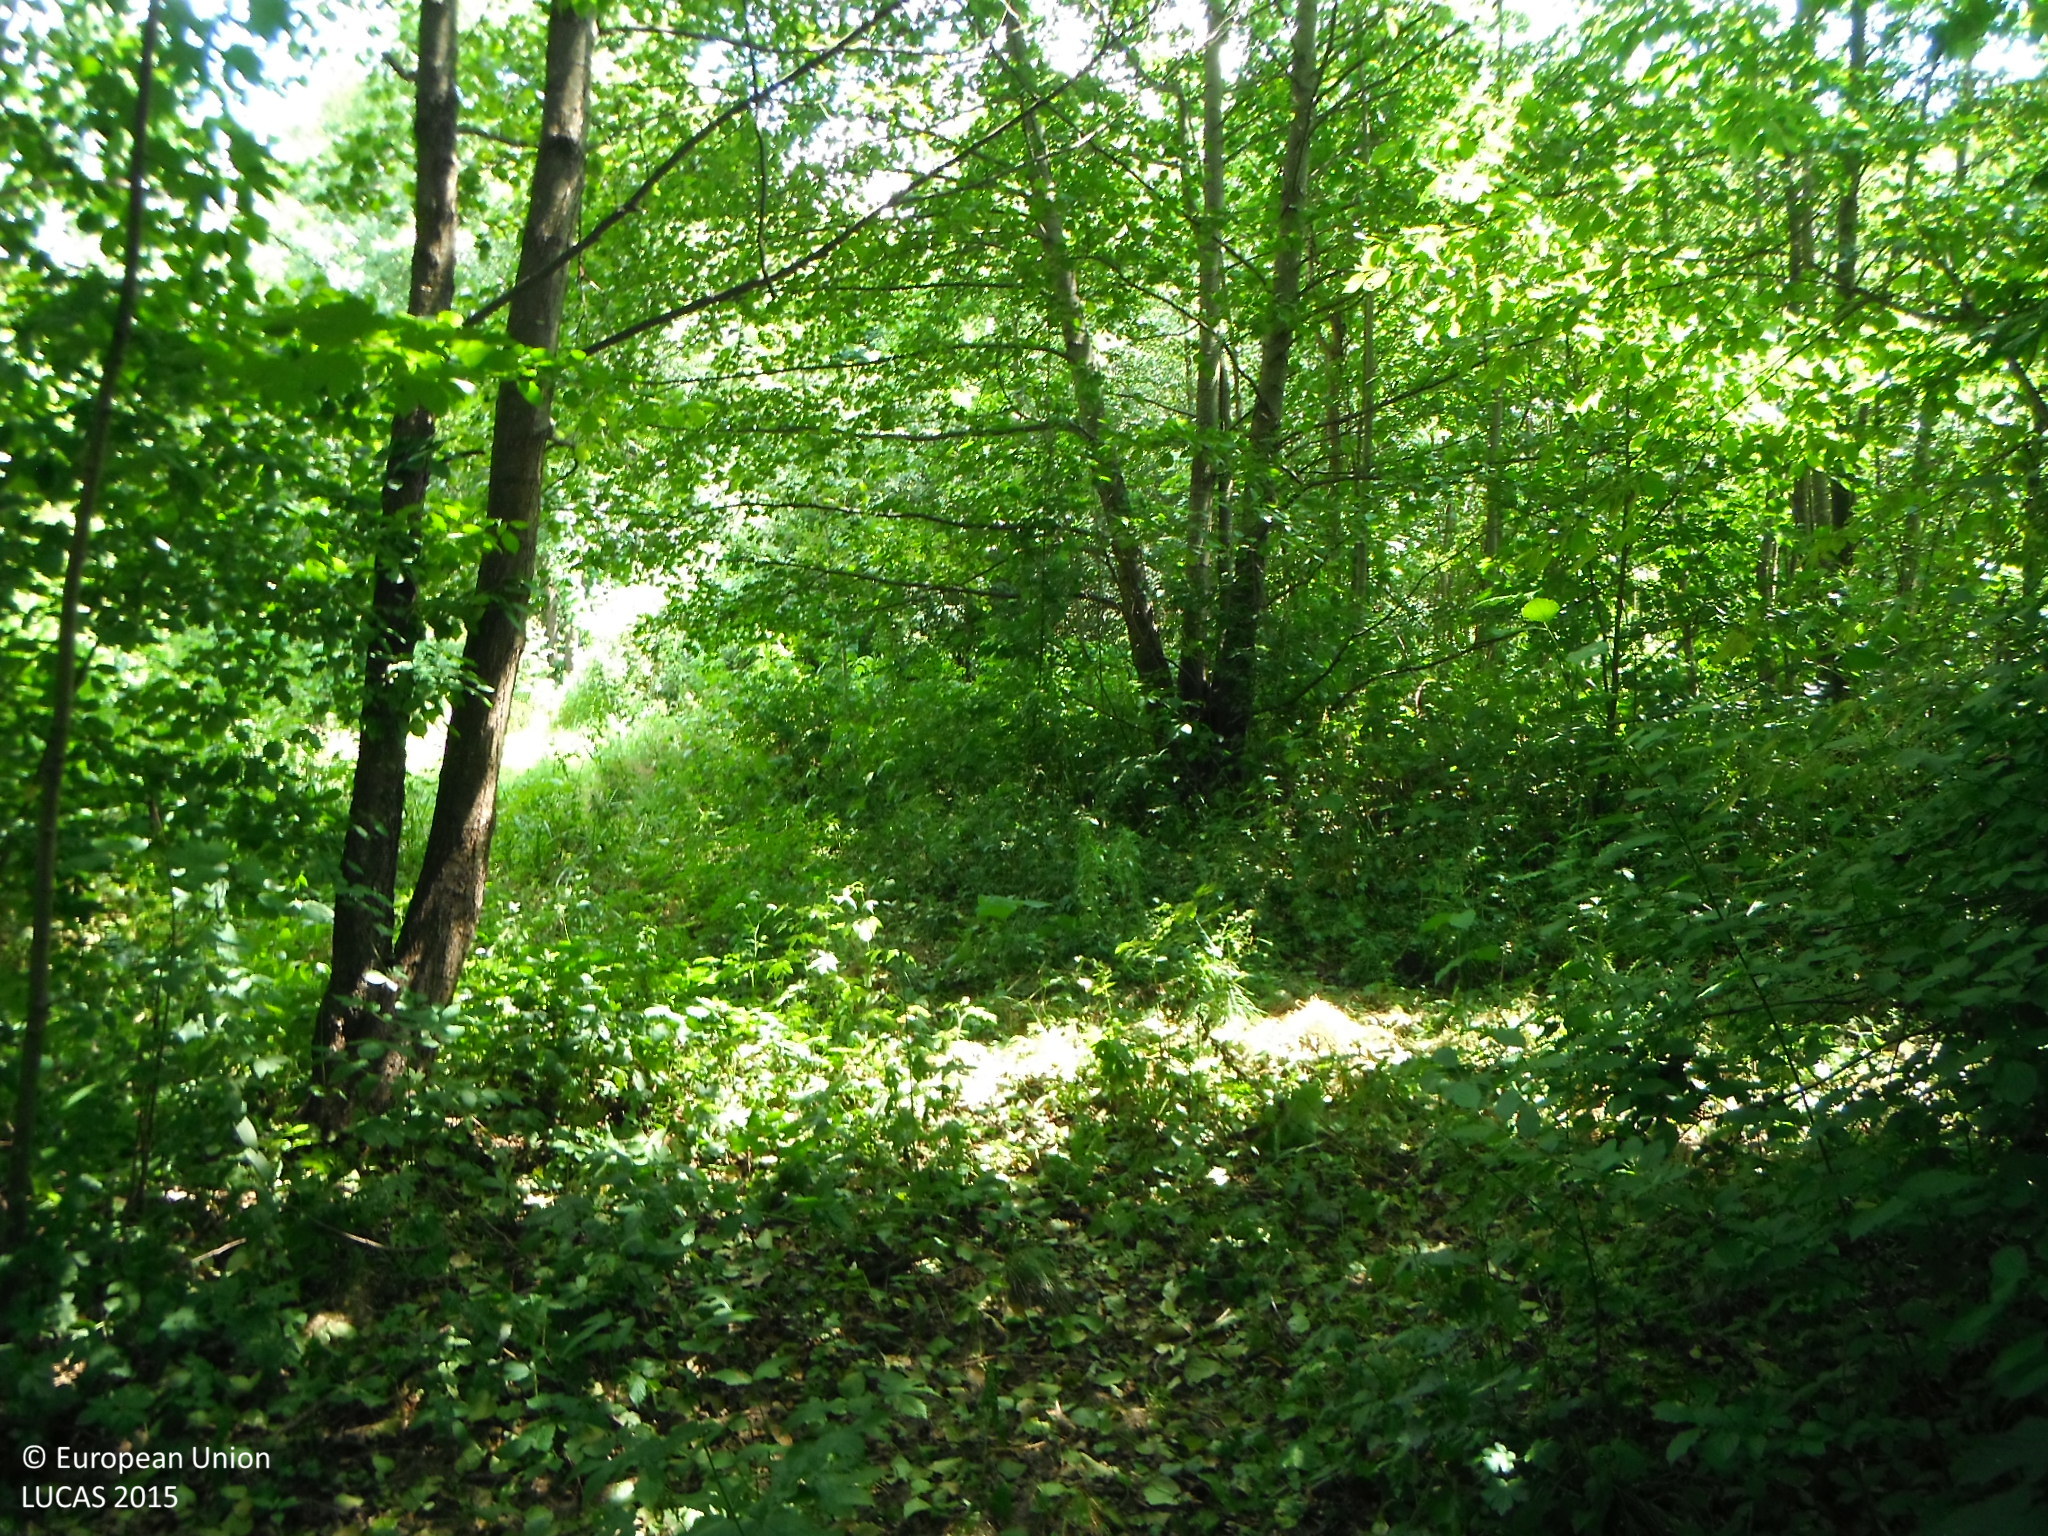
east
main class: Woodland
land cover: Broadleaved woodland
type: mesophytic deciduous forest
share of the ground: > 75 %
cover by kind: broadleaved forest trees 100 %
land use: Semi-natural and natural areas not in use
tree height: > 5 m
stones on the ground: < 10 %
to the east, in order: Broadleaved woodland; Tracks; Grassland with sparse tree/shrub cover; Broadleaved woodland; Tracks; Broadleaved woodland
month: July
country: SK
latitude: 48.7167
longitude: 20.1301
